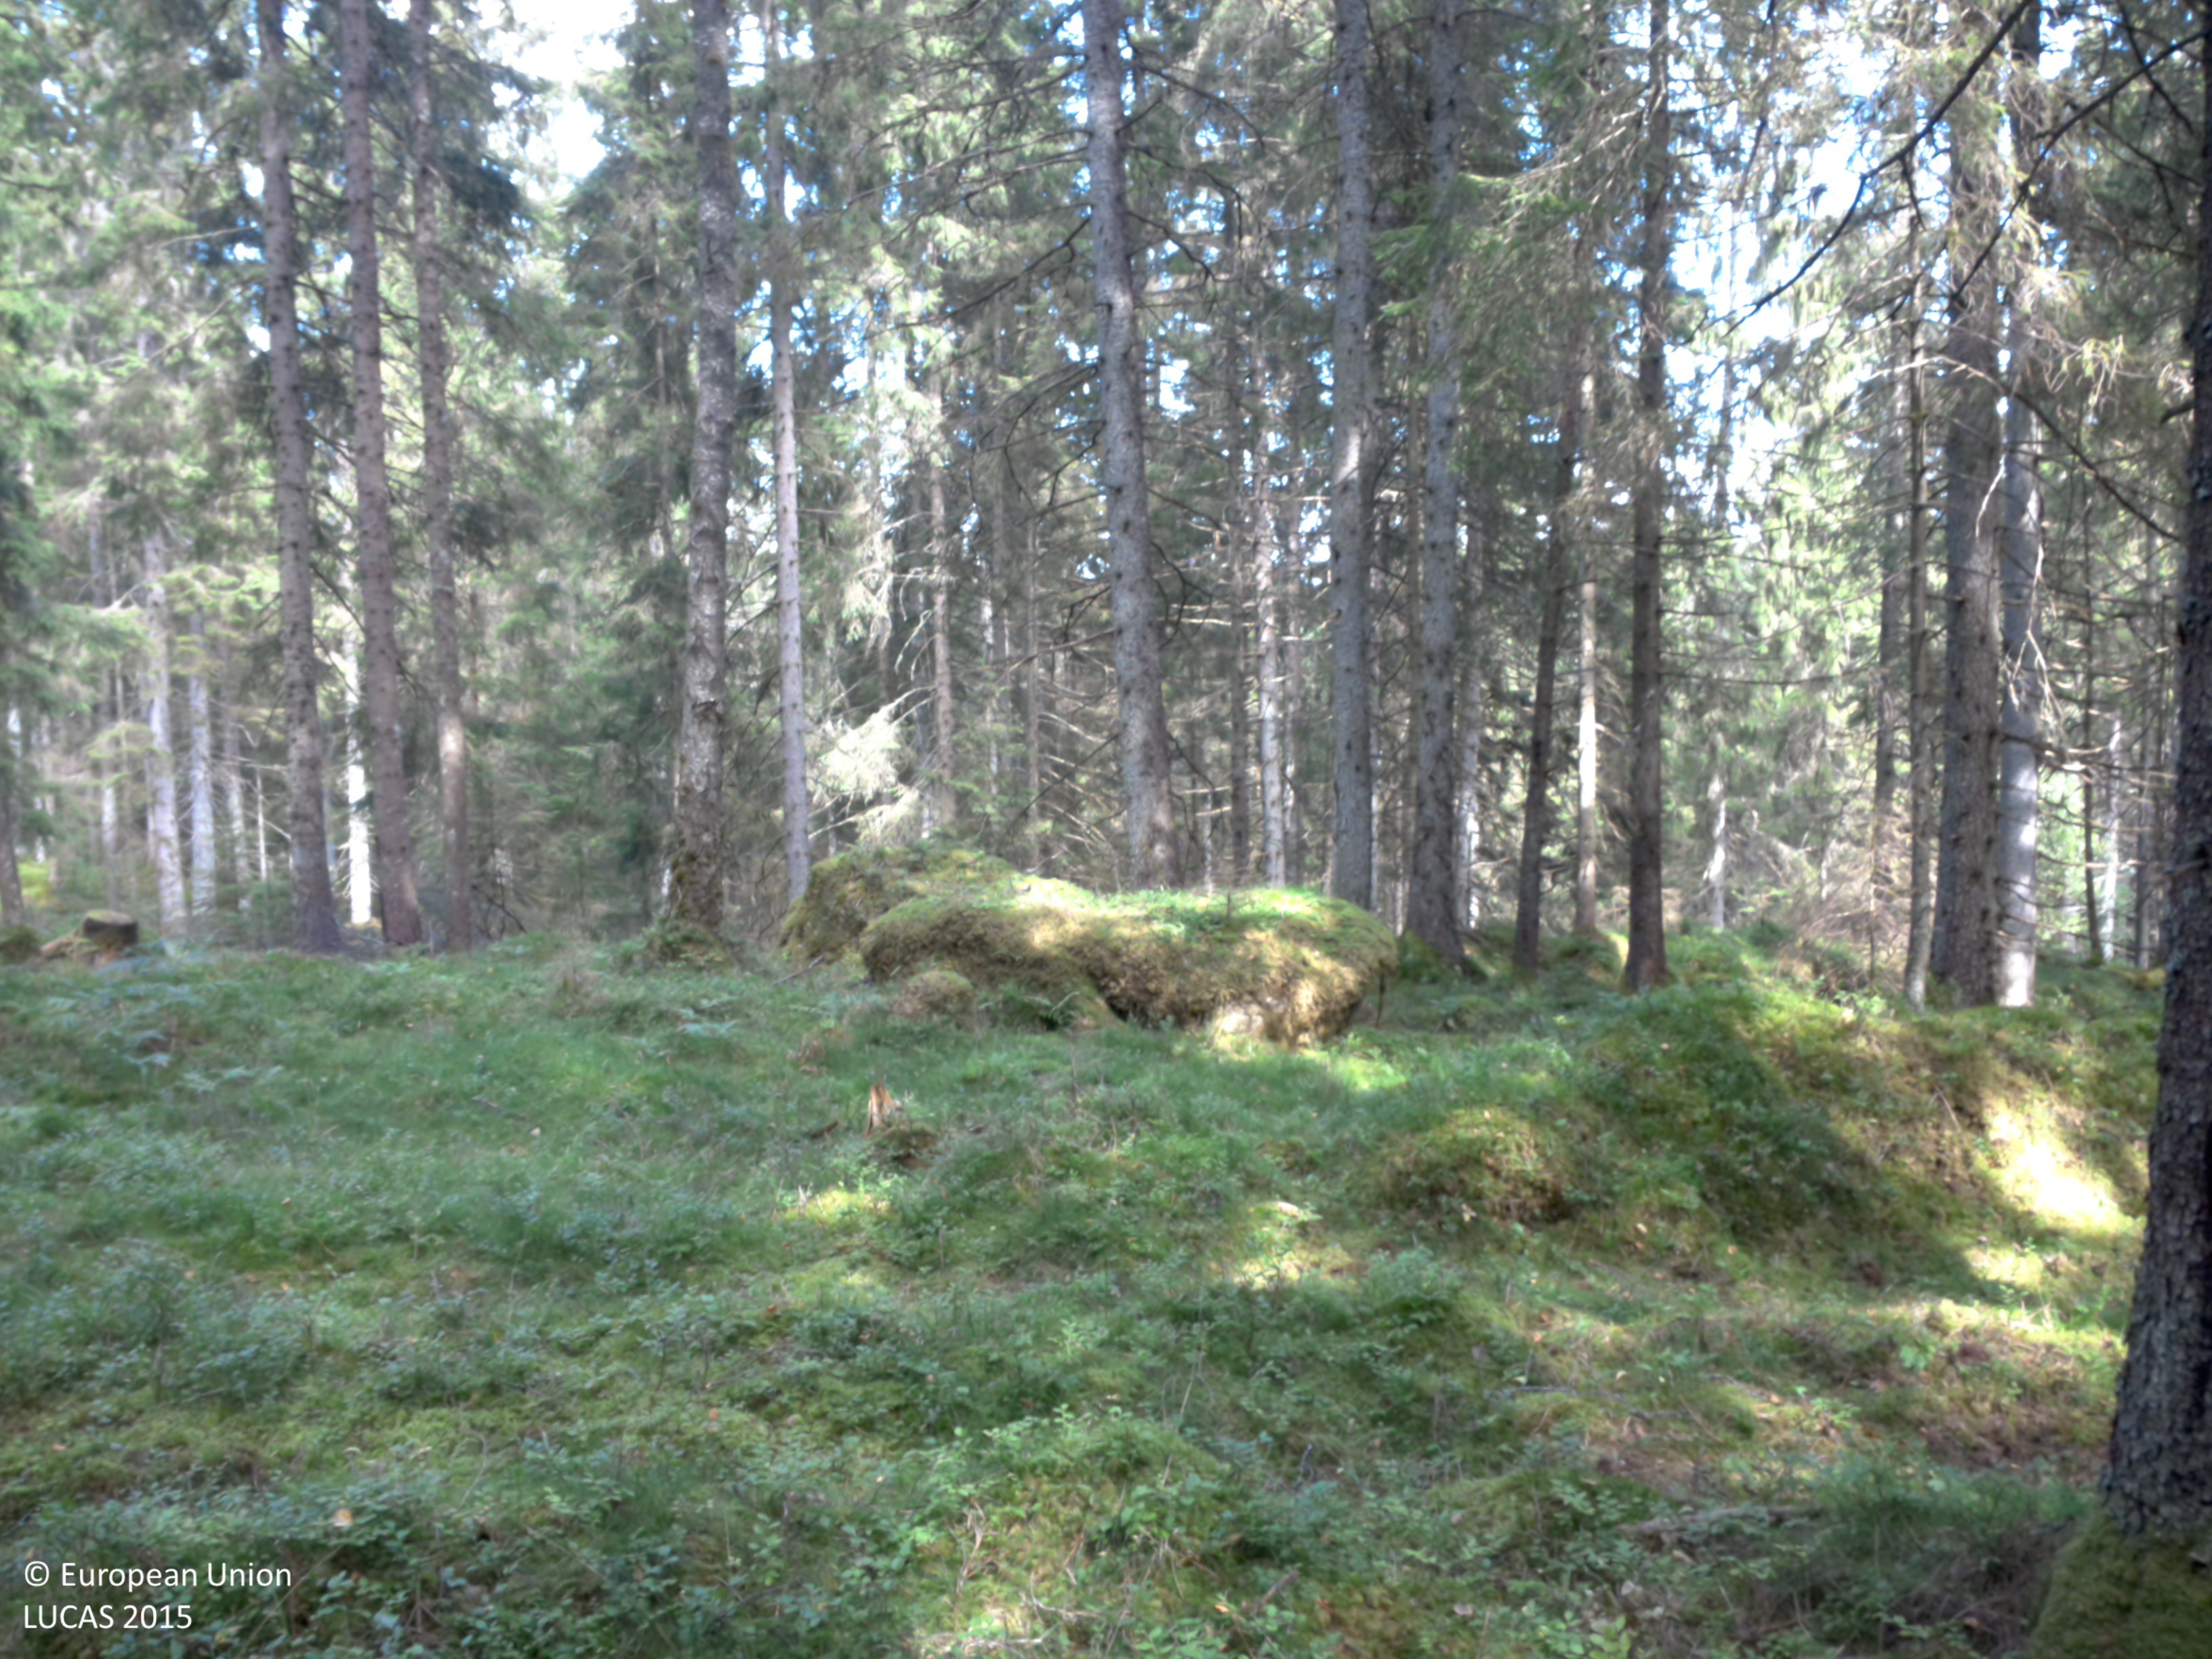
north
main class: Woodland
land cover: Spruce dominated coniferous woodland
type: boreal forest
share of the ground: 50 - 75 %
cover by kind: coniferous forest trees 60 %, lichens and mosses 30 %, shrubs 10 %
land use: Forestry
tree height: > 5 m
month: August
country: SE
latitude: 58.0017
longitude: 12.3140
